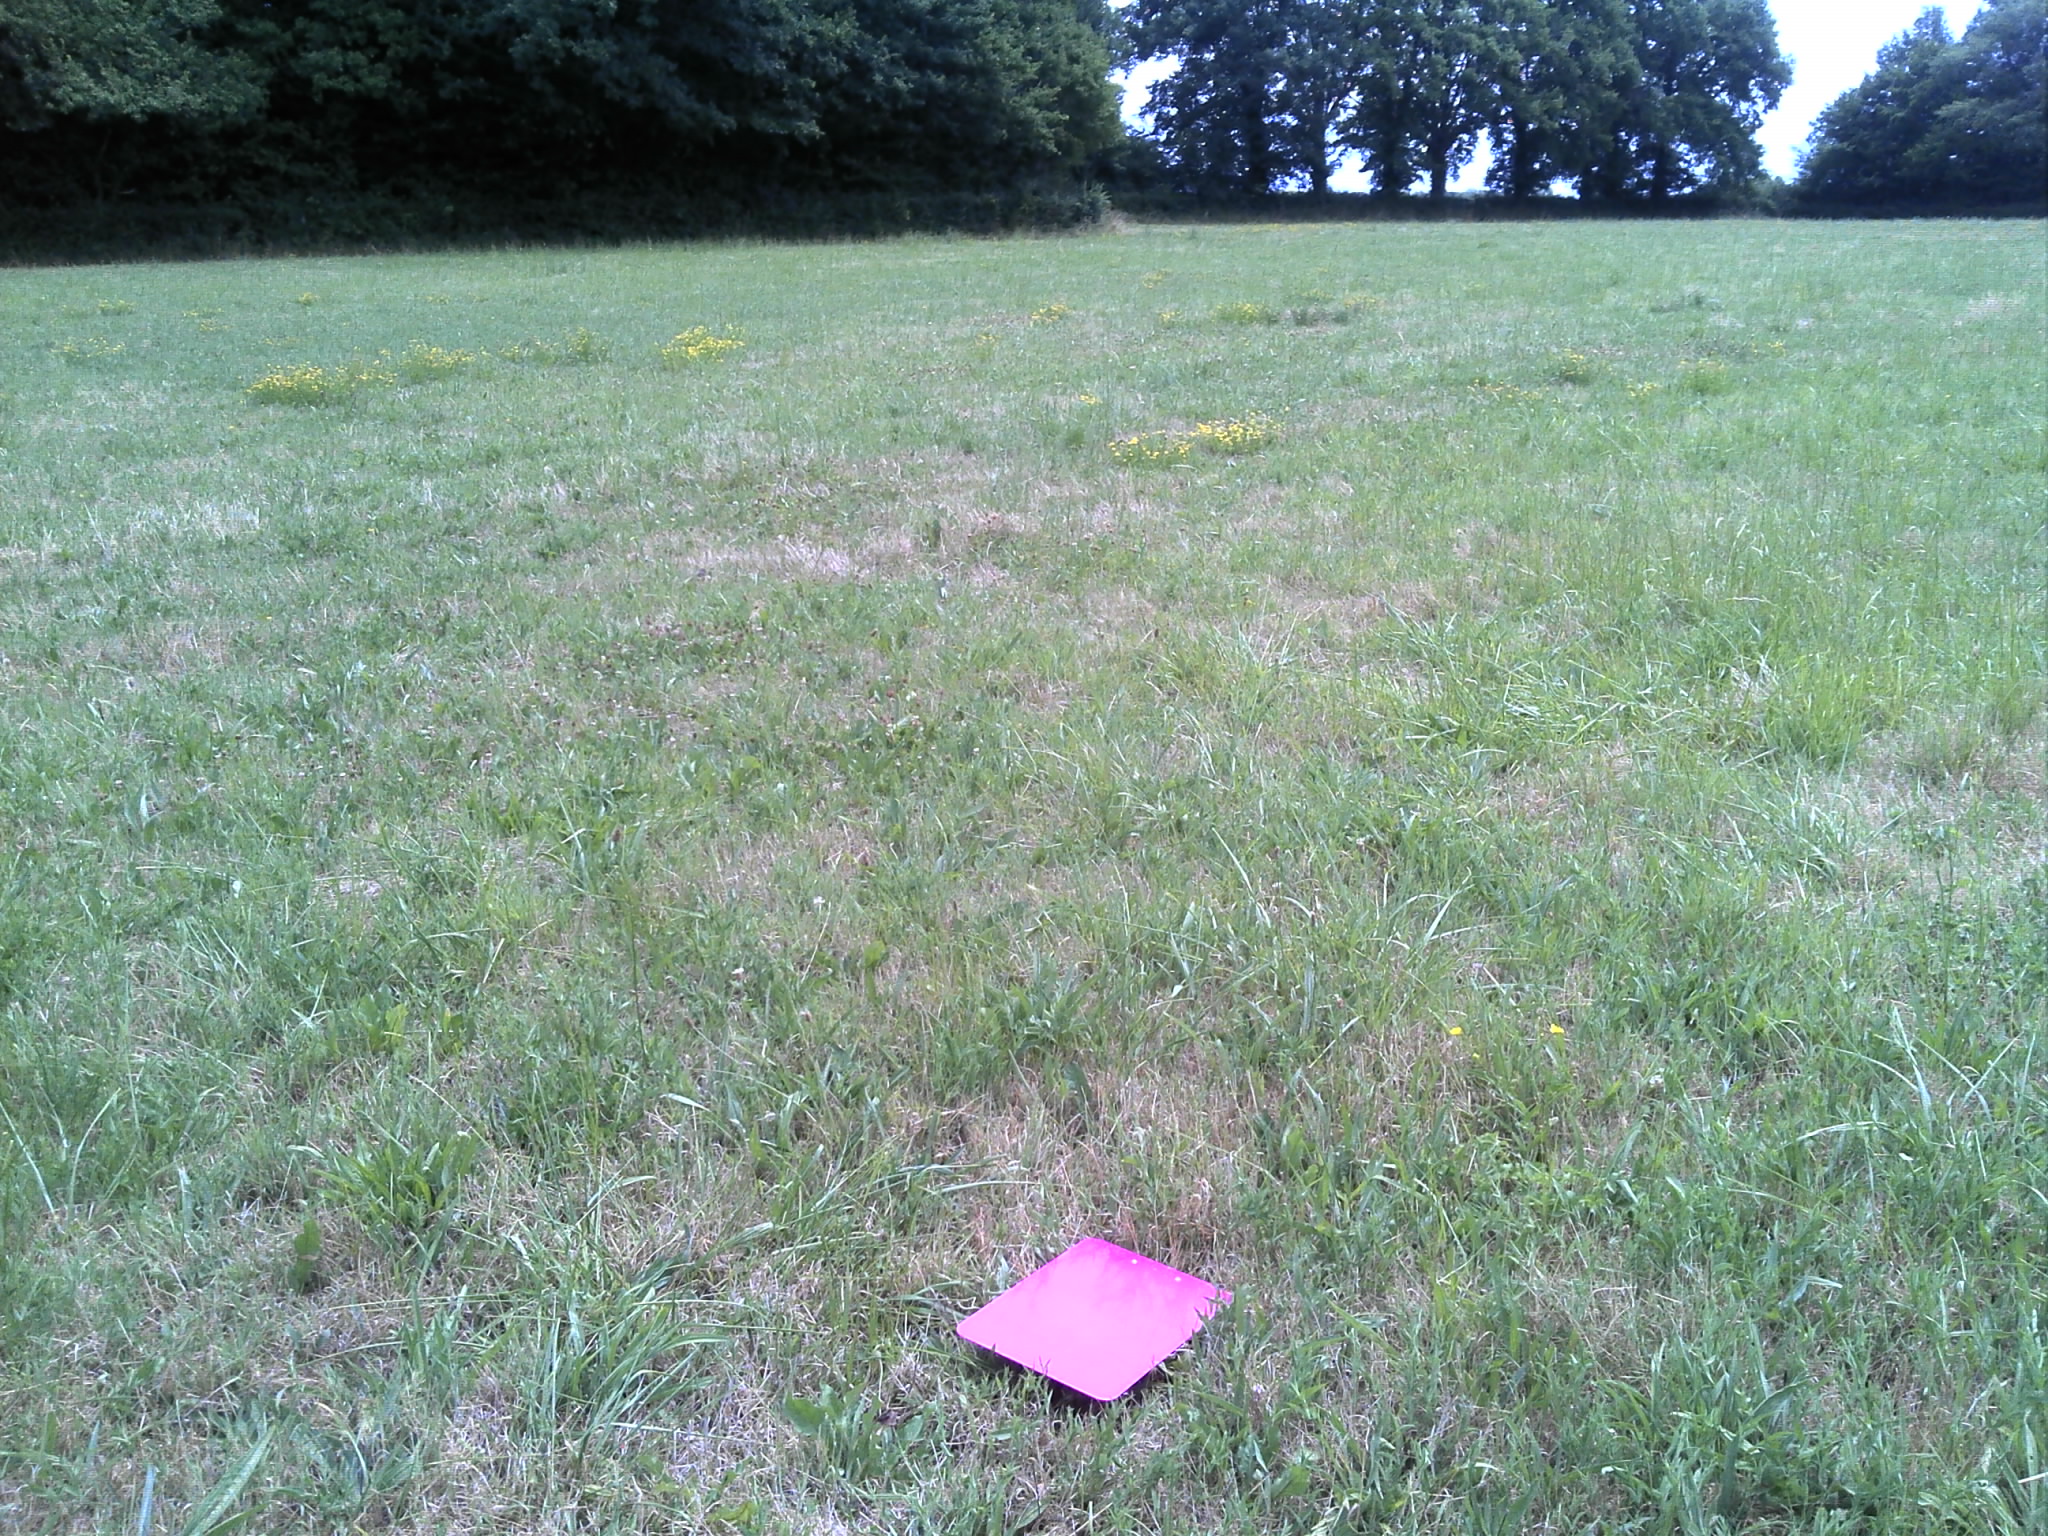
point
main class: Grassland
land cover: Grassland without tree/shrub cover
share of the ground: > 75 %
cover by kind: herbaceous plants 100 %
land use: Agriculture (excluding fallow land and kitchen gardens)
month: July
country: FR
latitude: 46.7184
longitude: 1.4982
